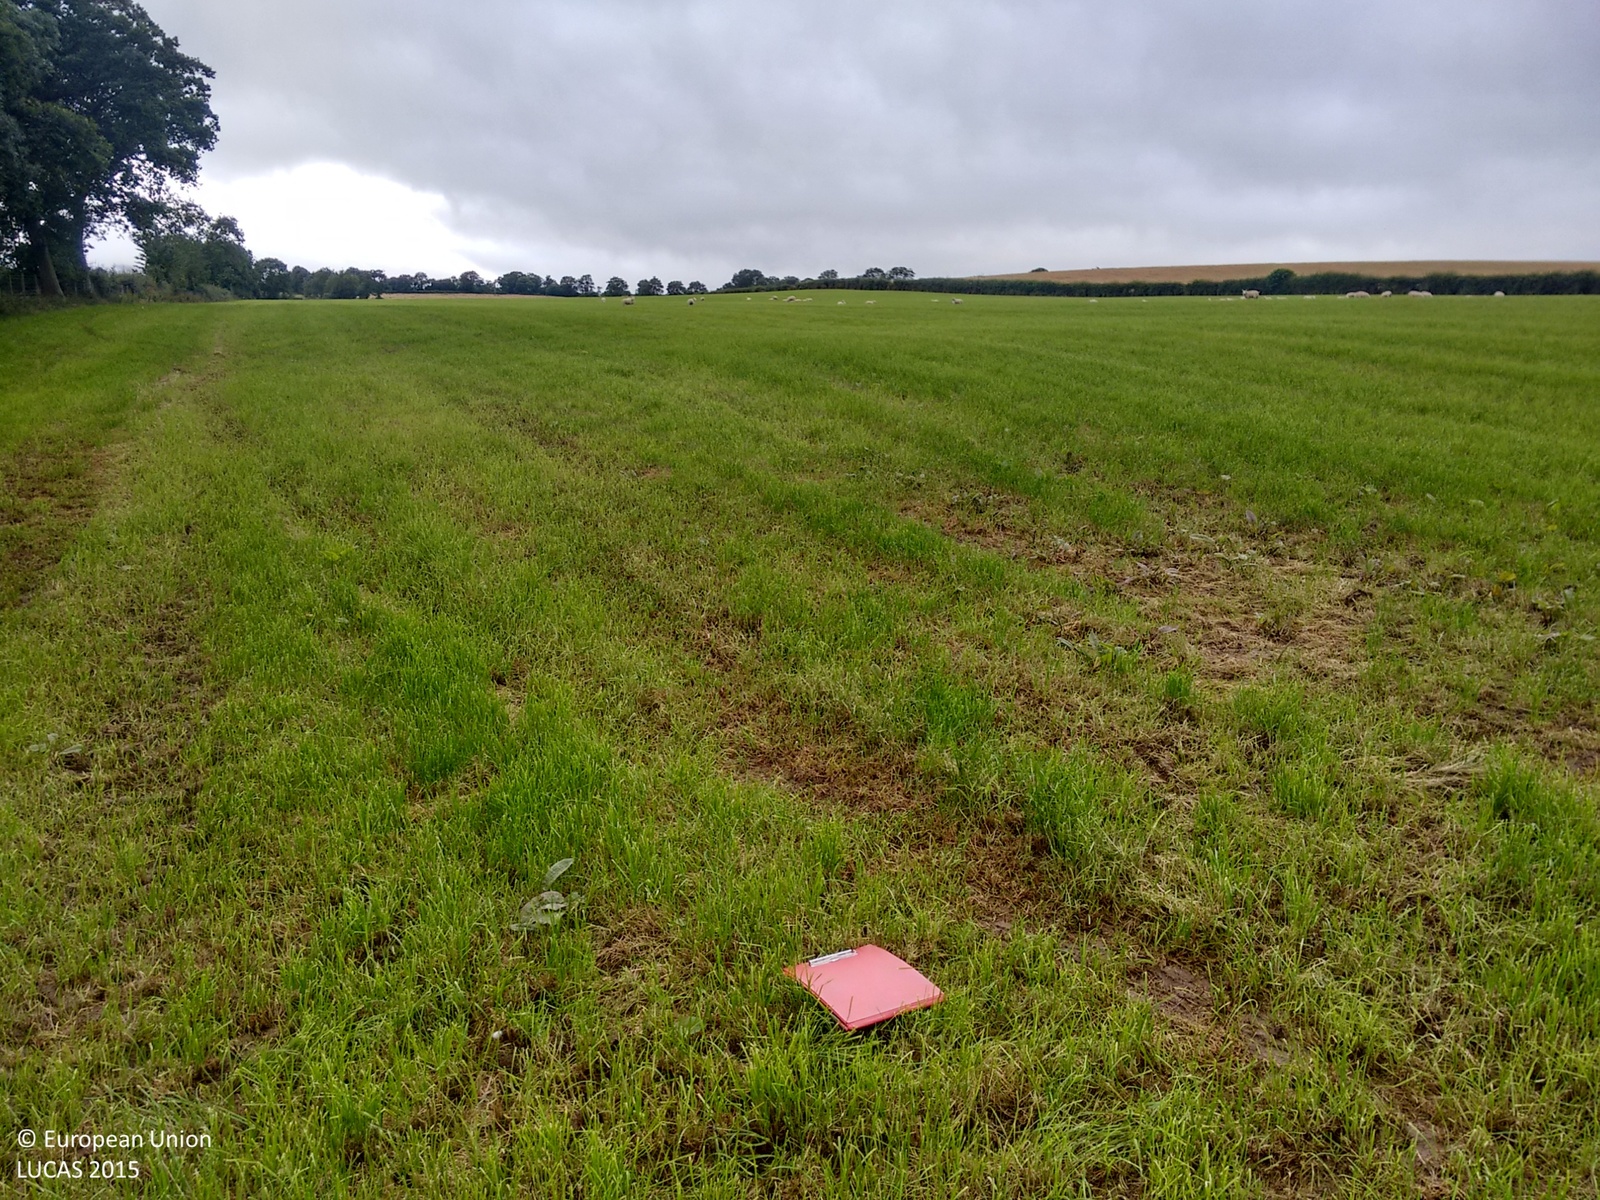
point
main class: Grassland
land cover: Grassland without tree/shrub cover
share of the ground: > 75 %
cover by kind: herbaceous plants 100 %
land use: Agriculture (excluding fallow land and kitchen gardens)
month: August
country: GB
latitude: 54.7617
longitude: -2.9545
